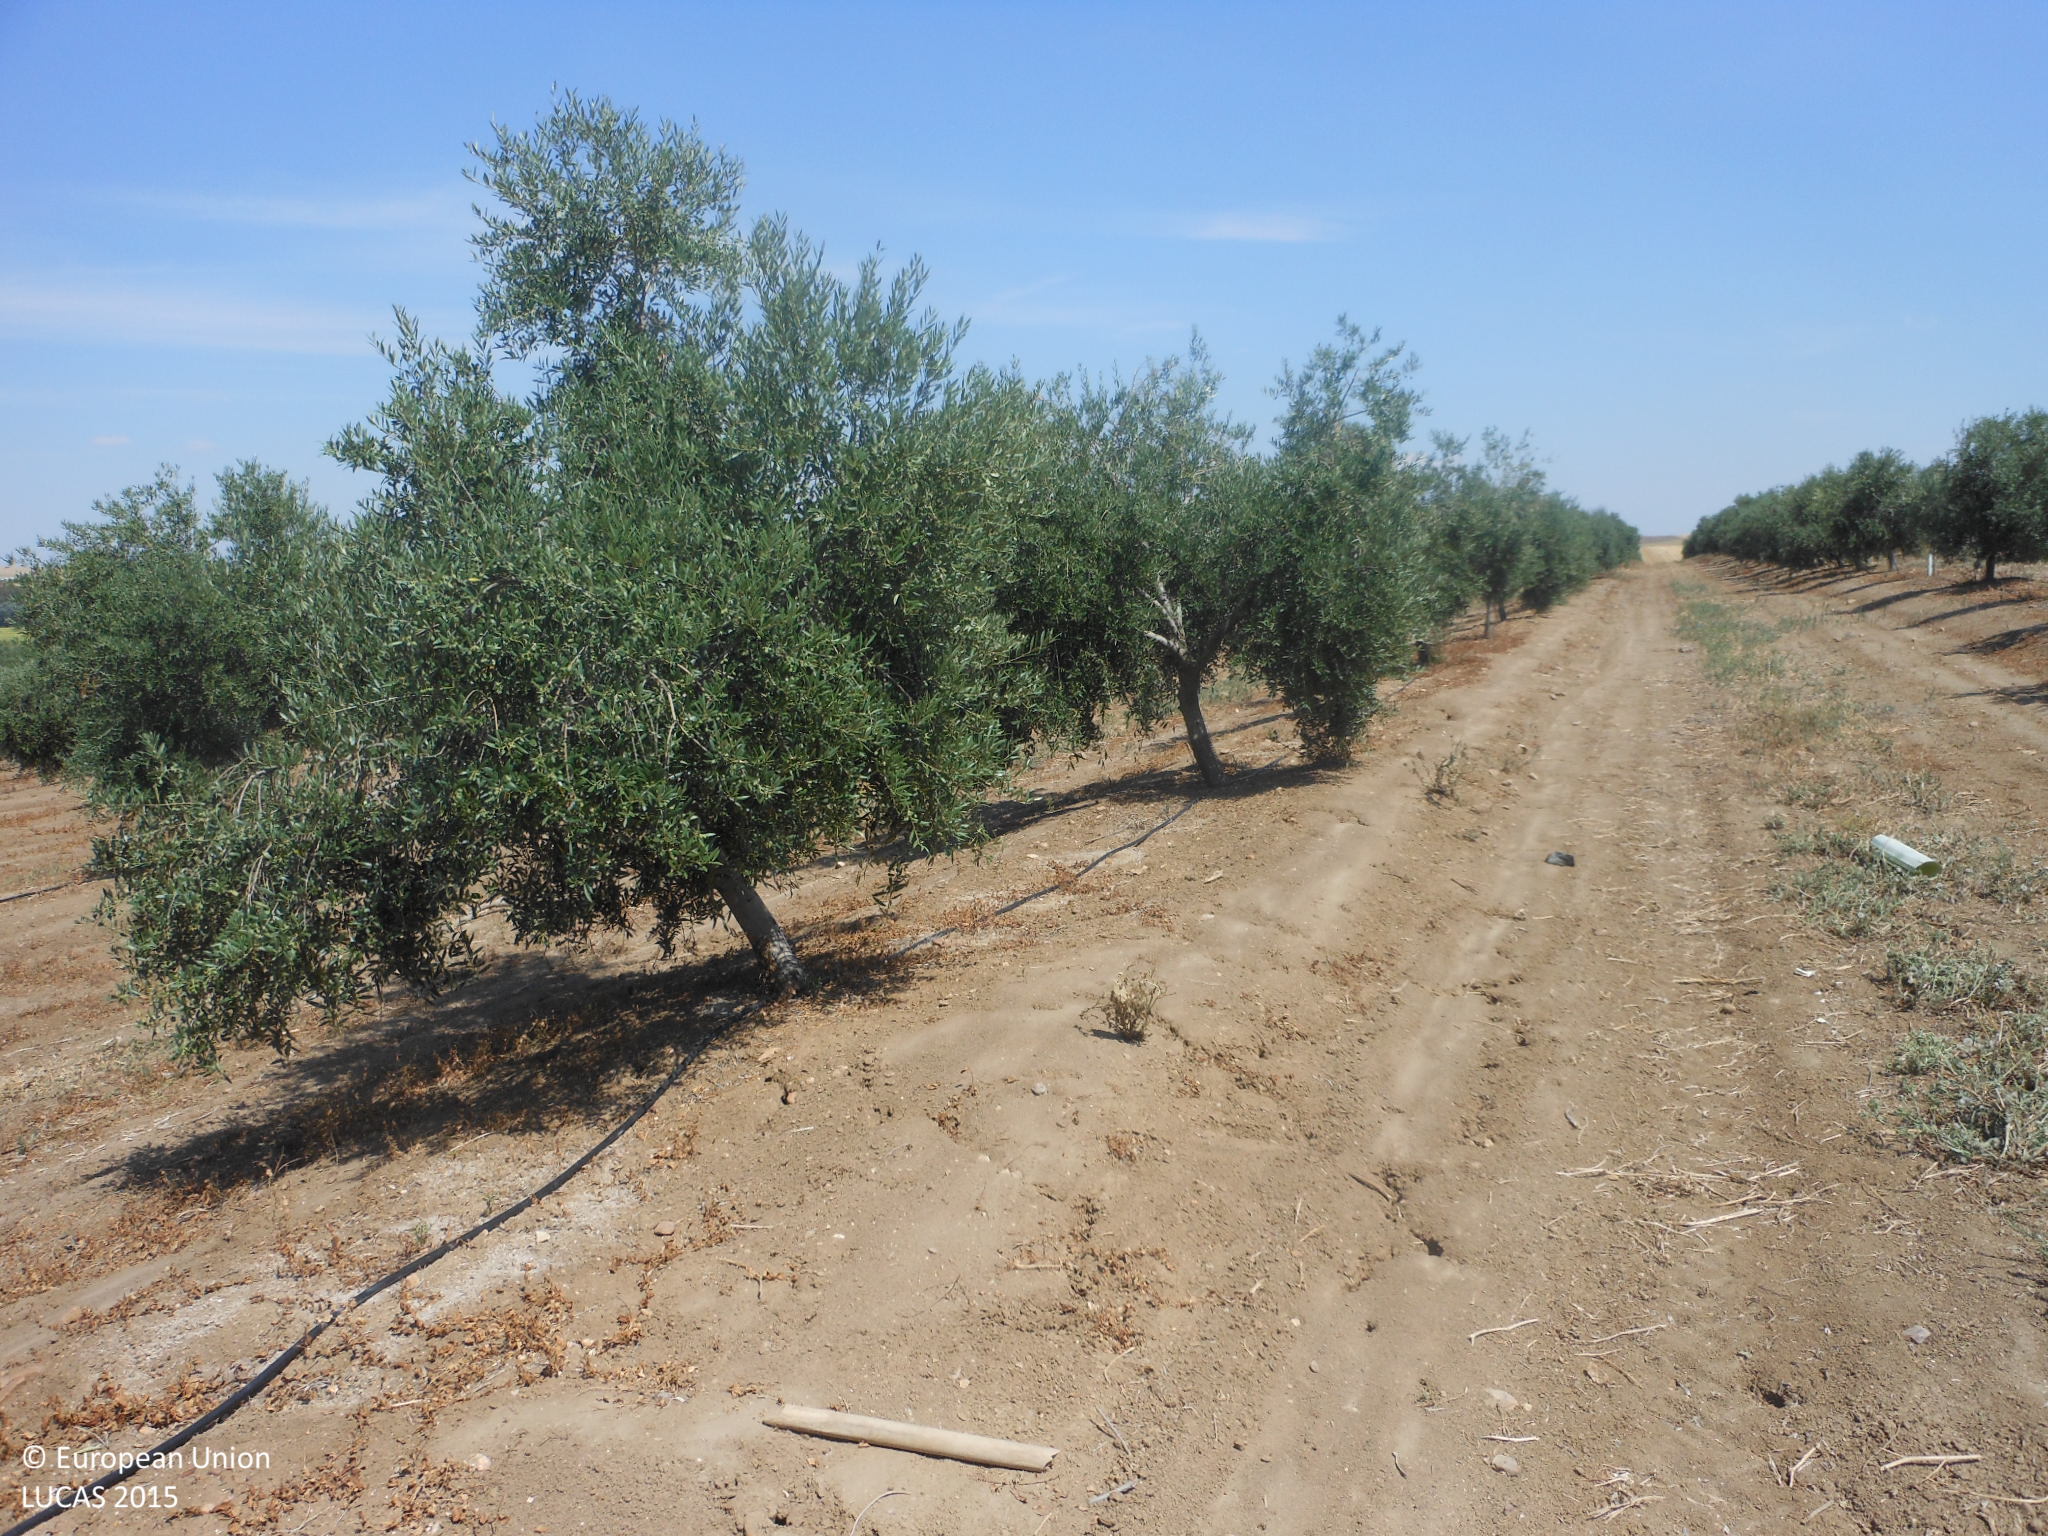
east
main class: Cropland
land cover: Olive groves
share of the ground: 50 - 75 %
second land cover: Other bare soil
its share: > 75 %
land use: Agriculture (excluding fallow land and kitchen gardens)
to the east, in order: Olive groves; Other bare soil
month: June
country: ES
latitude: 37.6424
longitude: -5.1910
